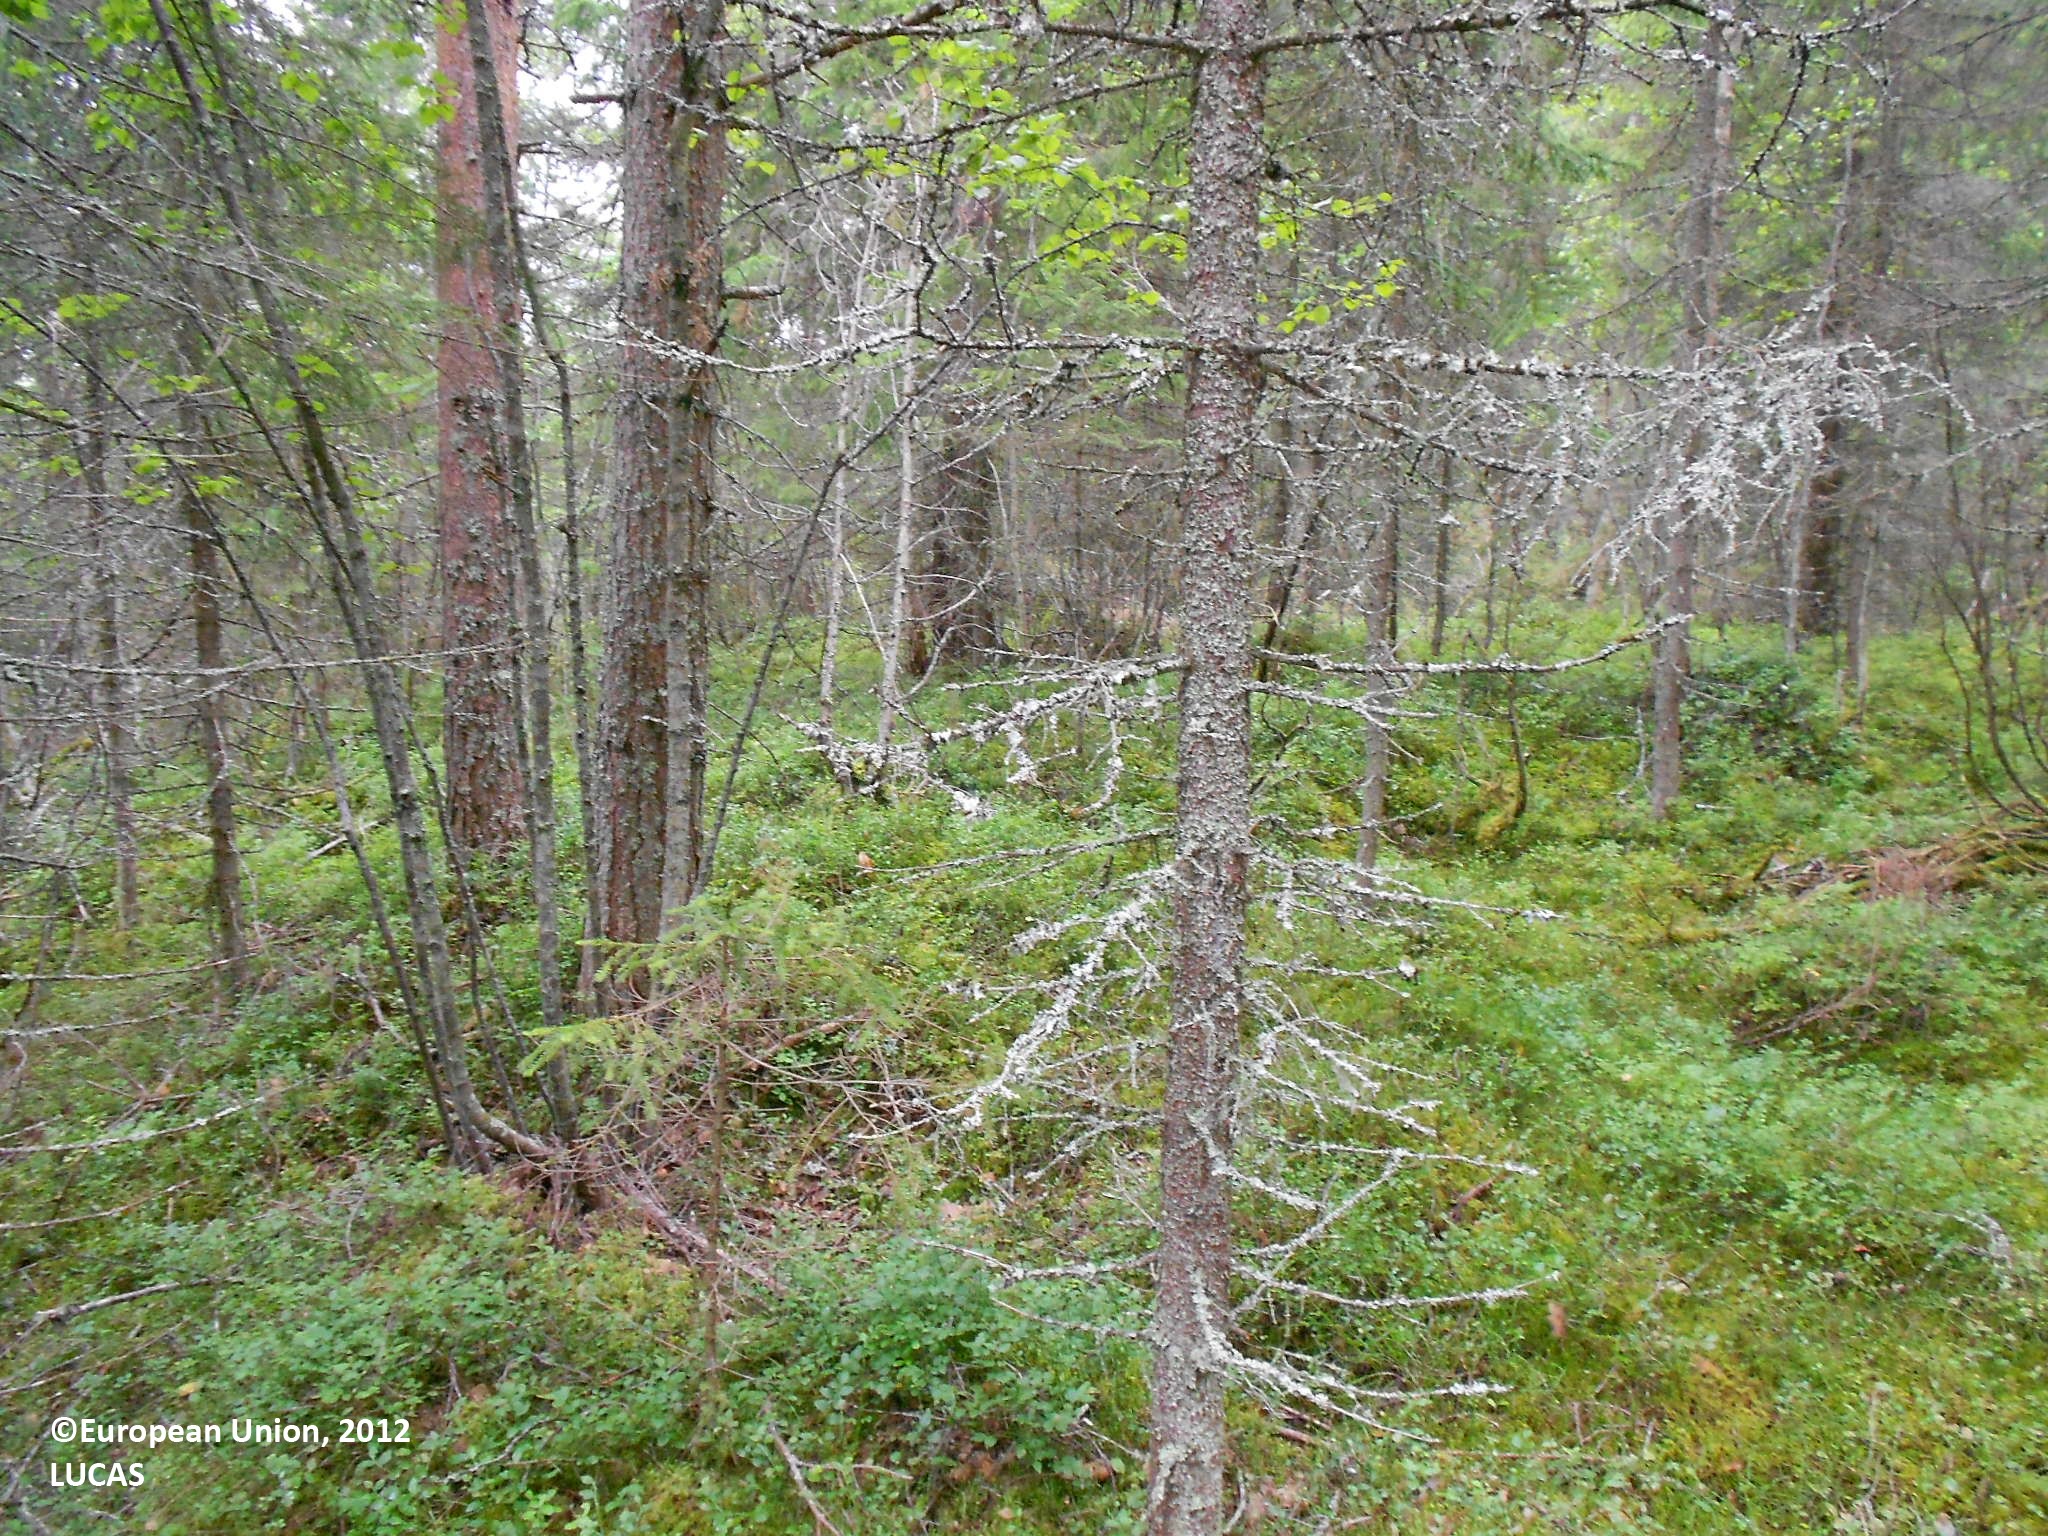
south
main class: Woodland
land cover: Spruce dominated coniferous woodland
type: boreal forest
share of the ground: > 75 %
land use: Forestry
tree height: > 5 m
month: August
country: FI
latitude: 63.4656
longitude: 28.9247
